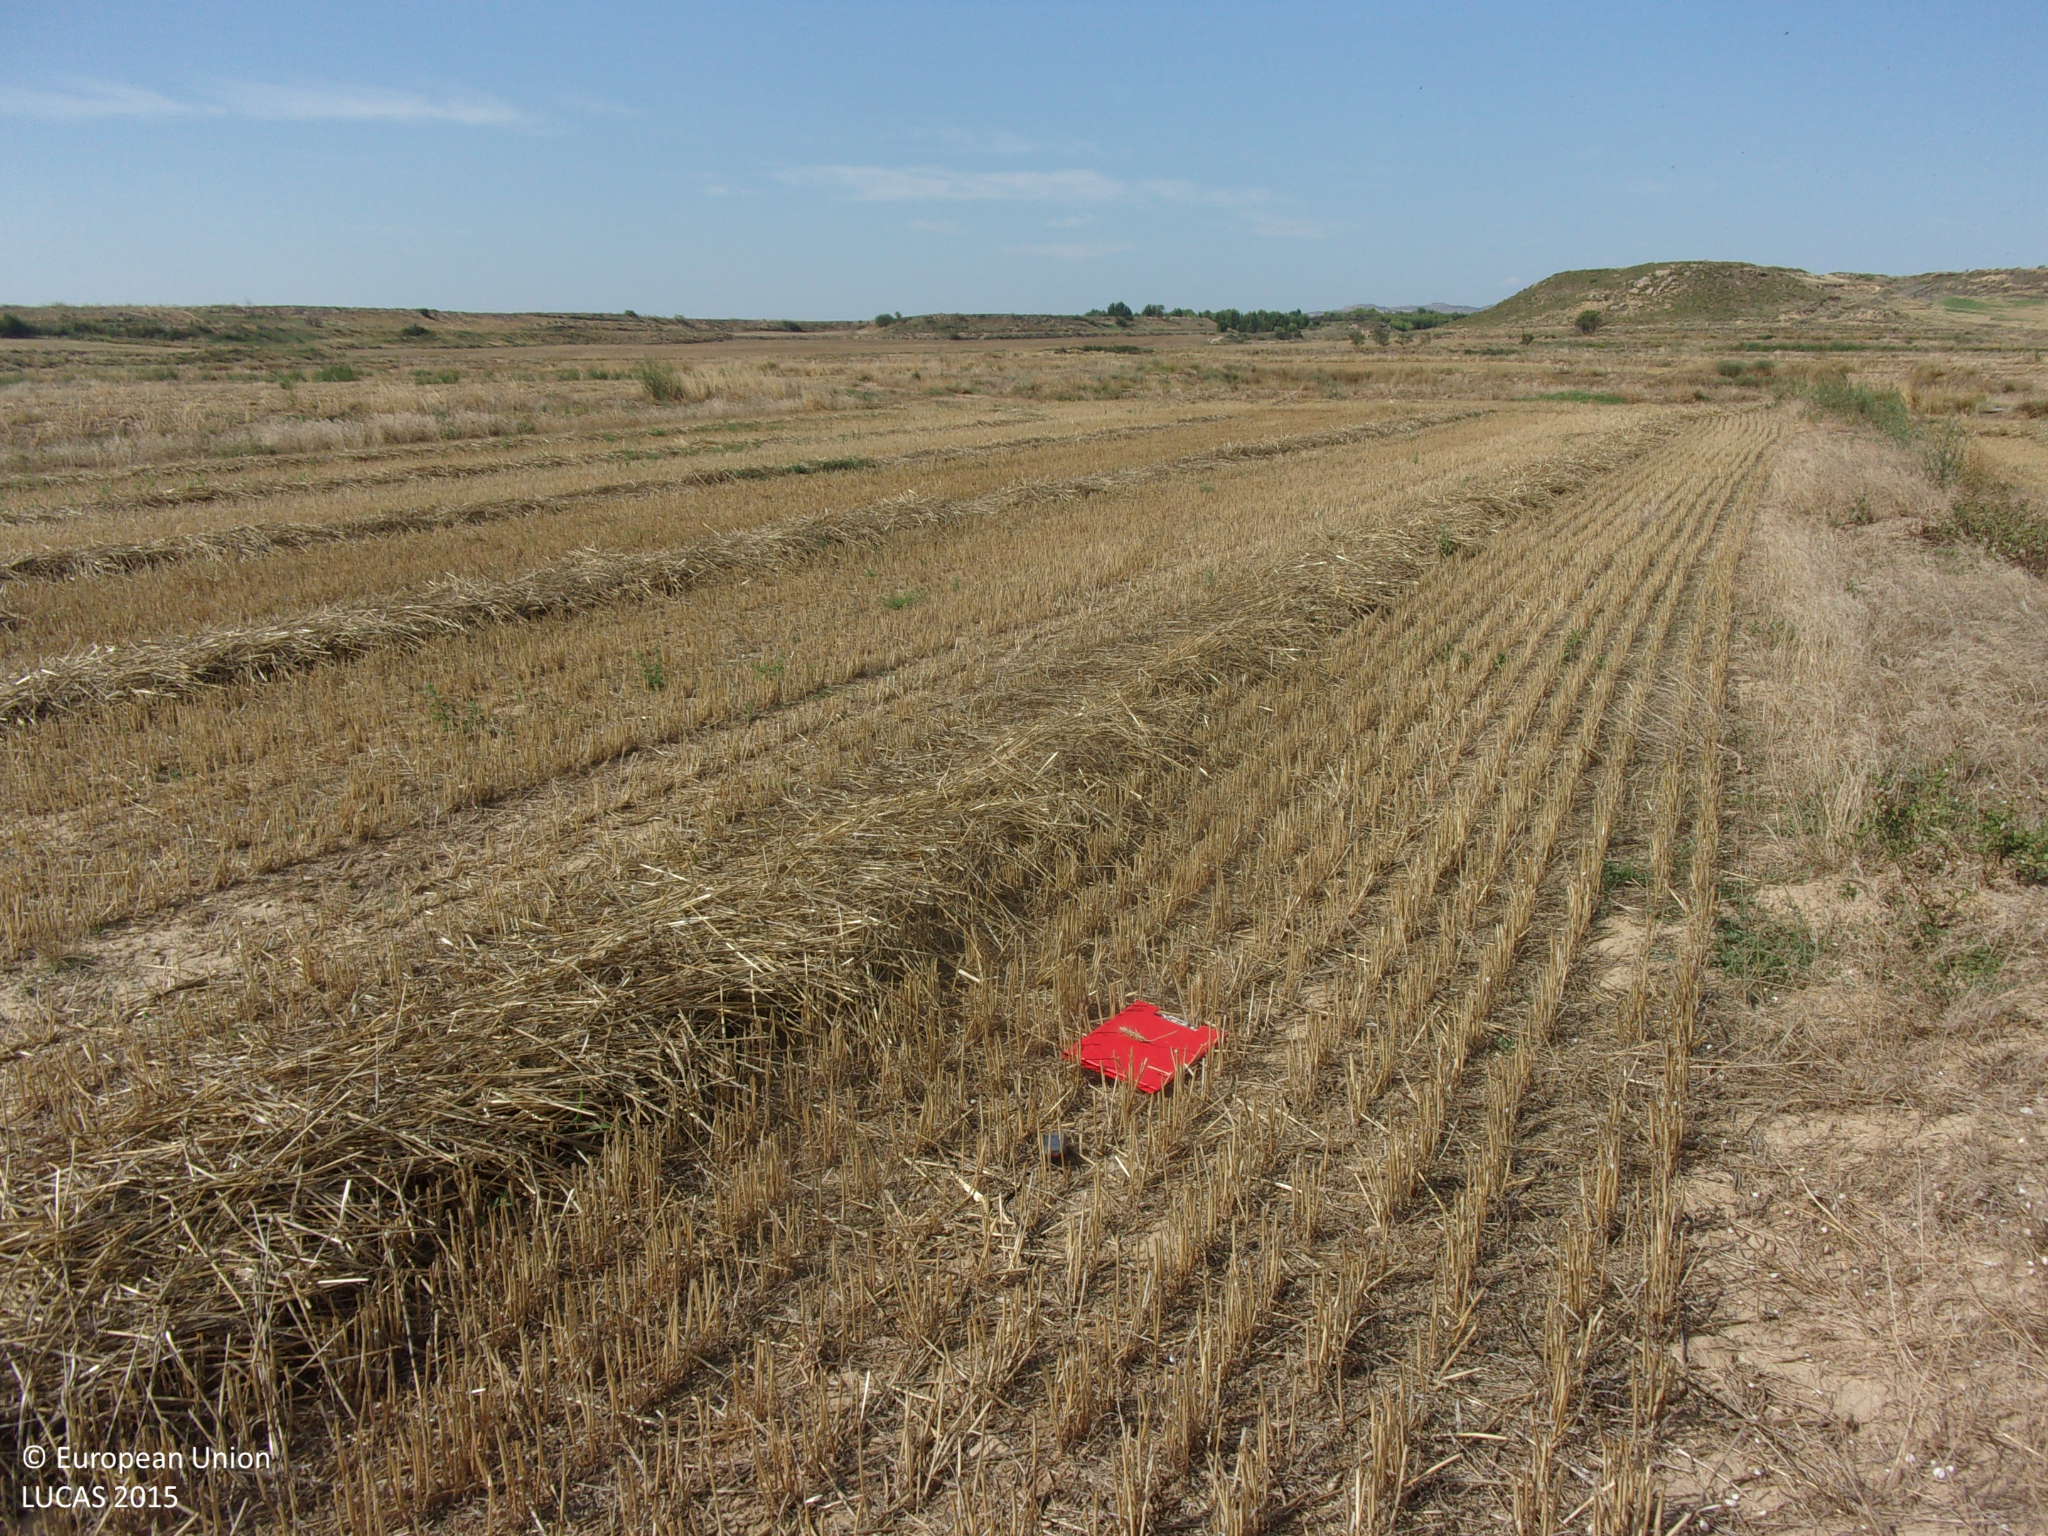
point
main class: Cropland
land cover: Common wheat
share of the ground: < 10 %
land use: Agriculture (excluding fallow land and kitchen gardens)
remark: Harvested field
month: August
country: ES
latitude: 42.1994
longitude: -1.1587
